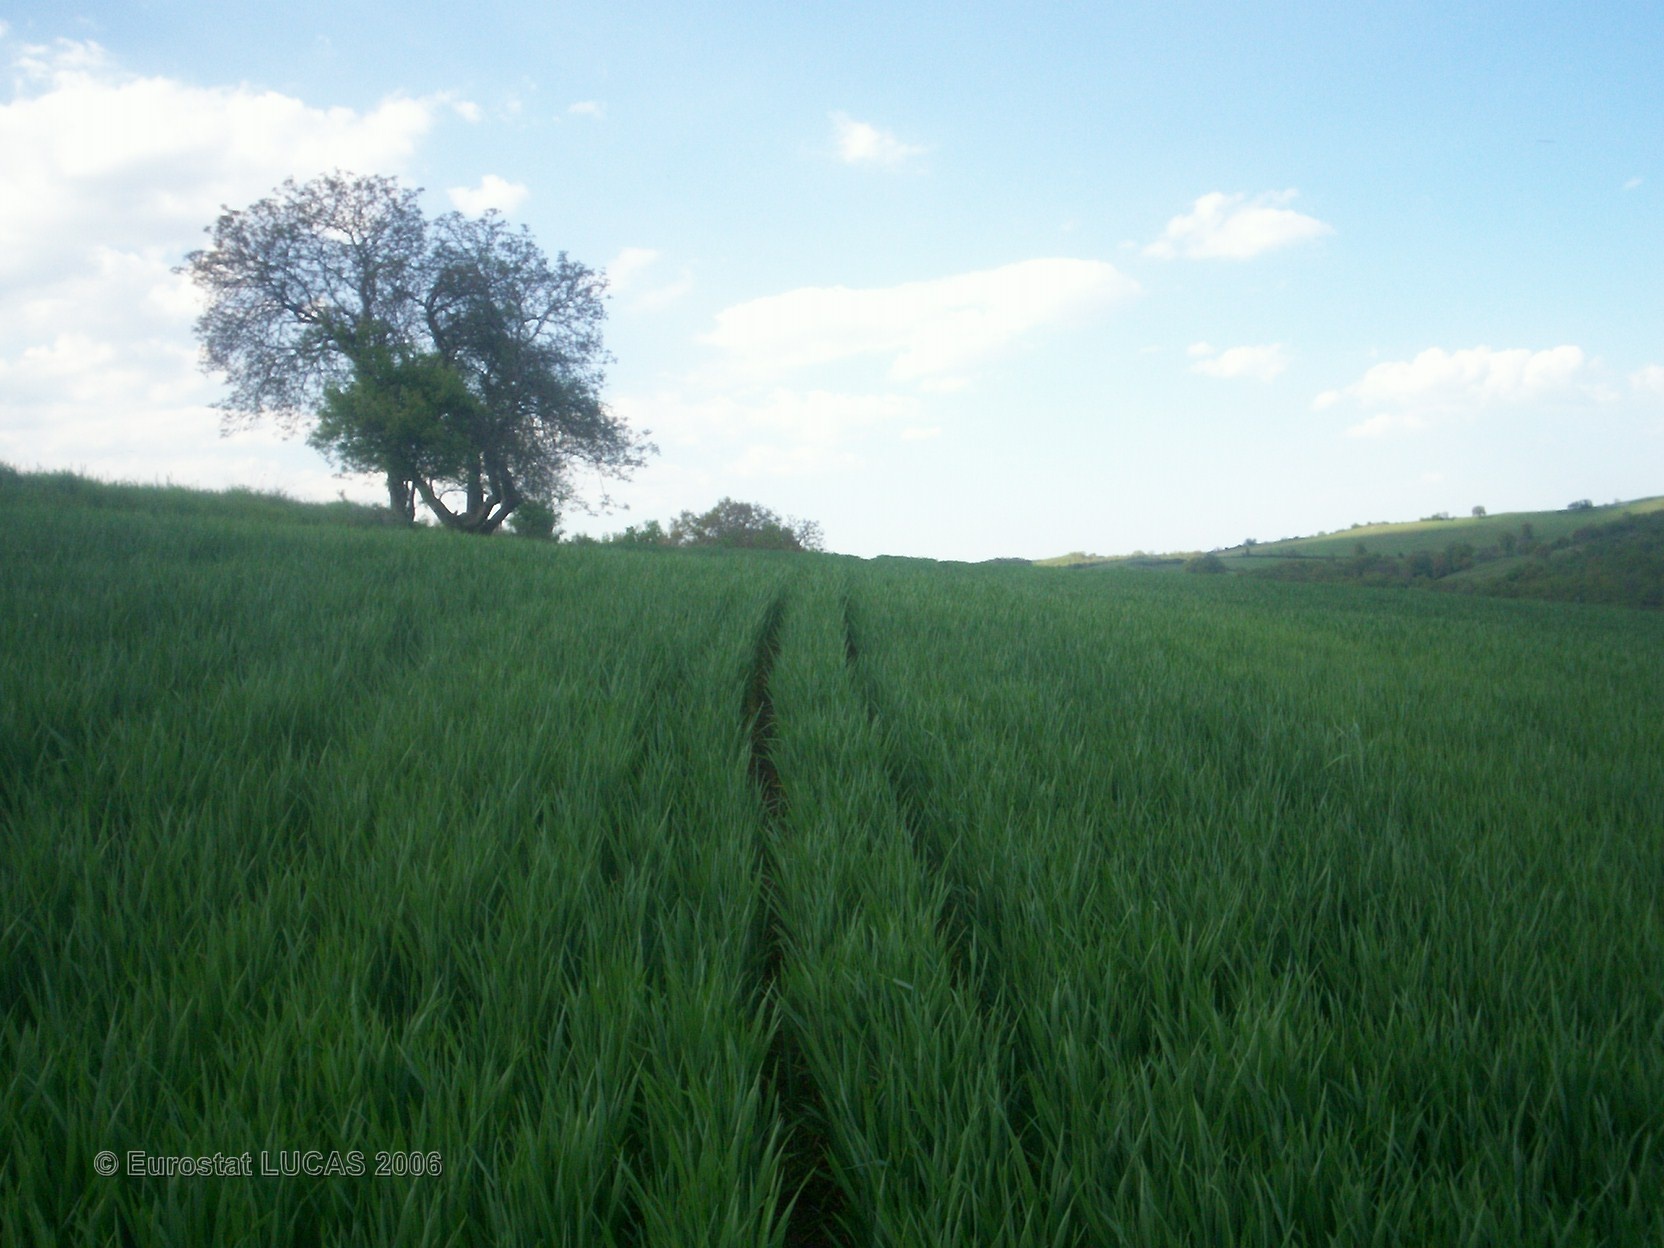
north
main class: Cropland
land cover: Common wheat
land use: Agriculture (excluding fallow land and kitchen gardens)
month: May
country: FR
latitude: 46.0174
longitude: 3.0627
